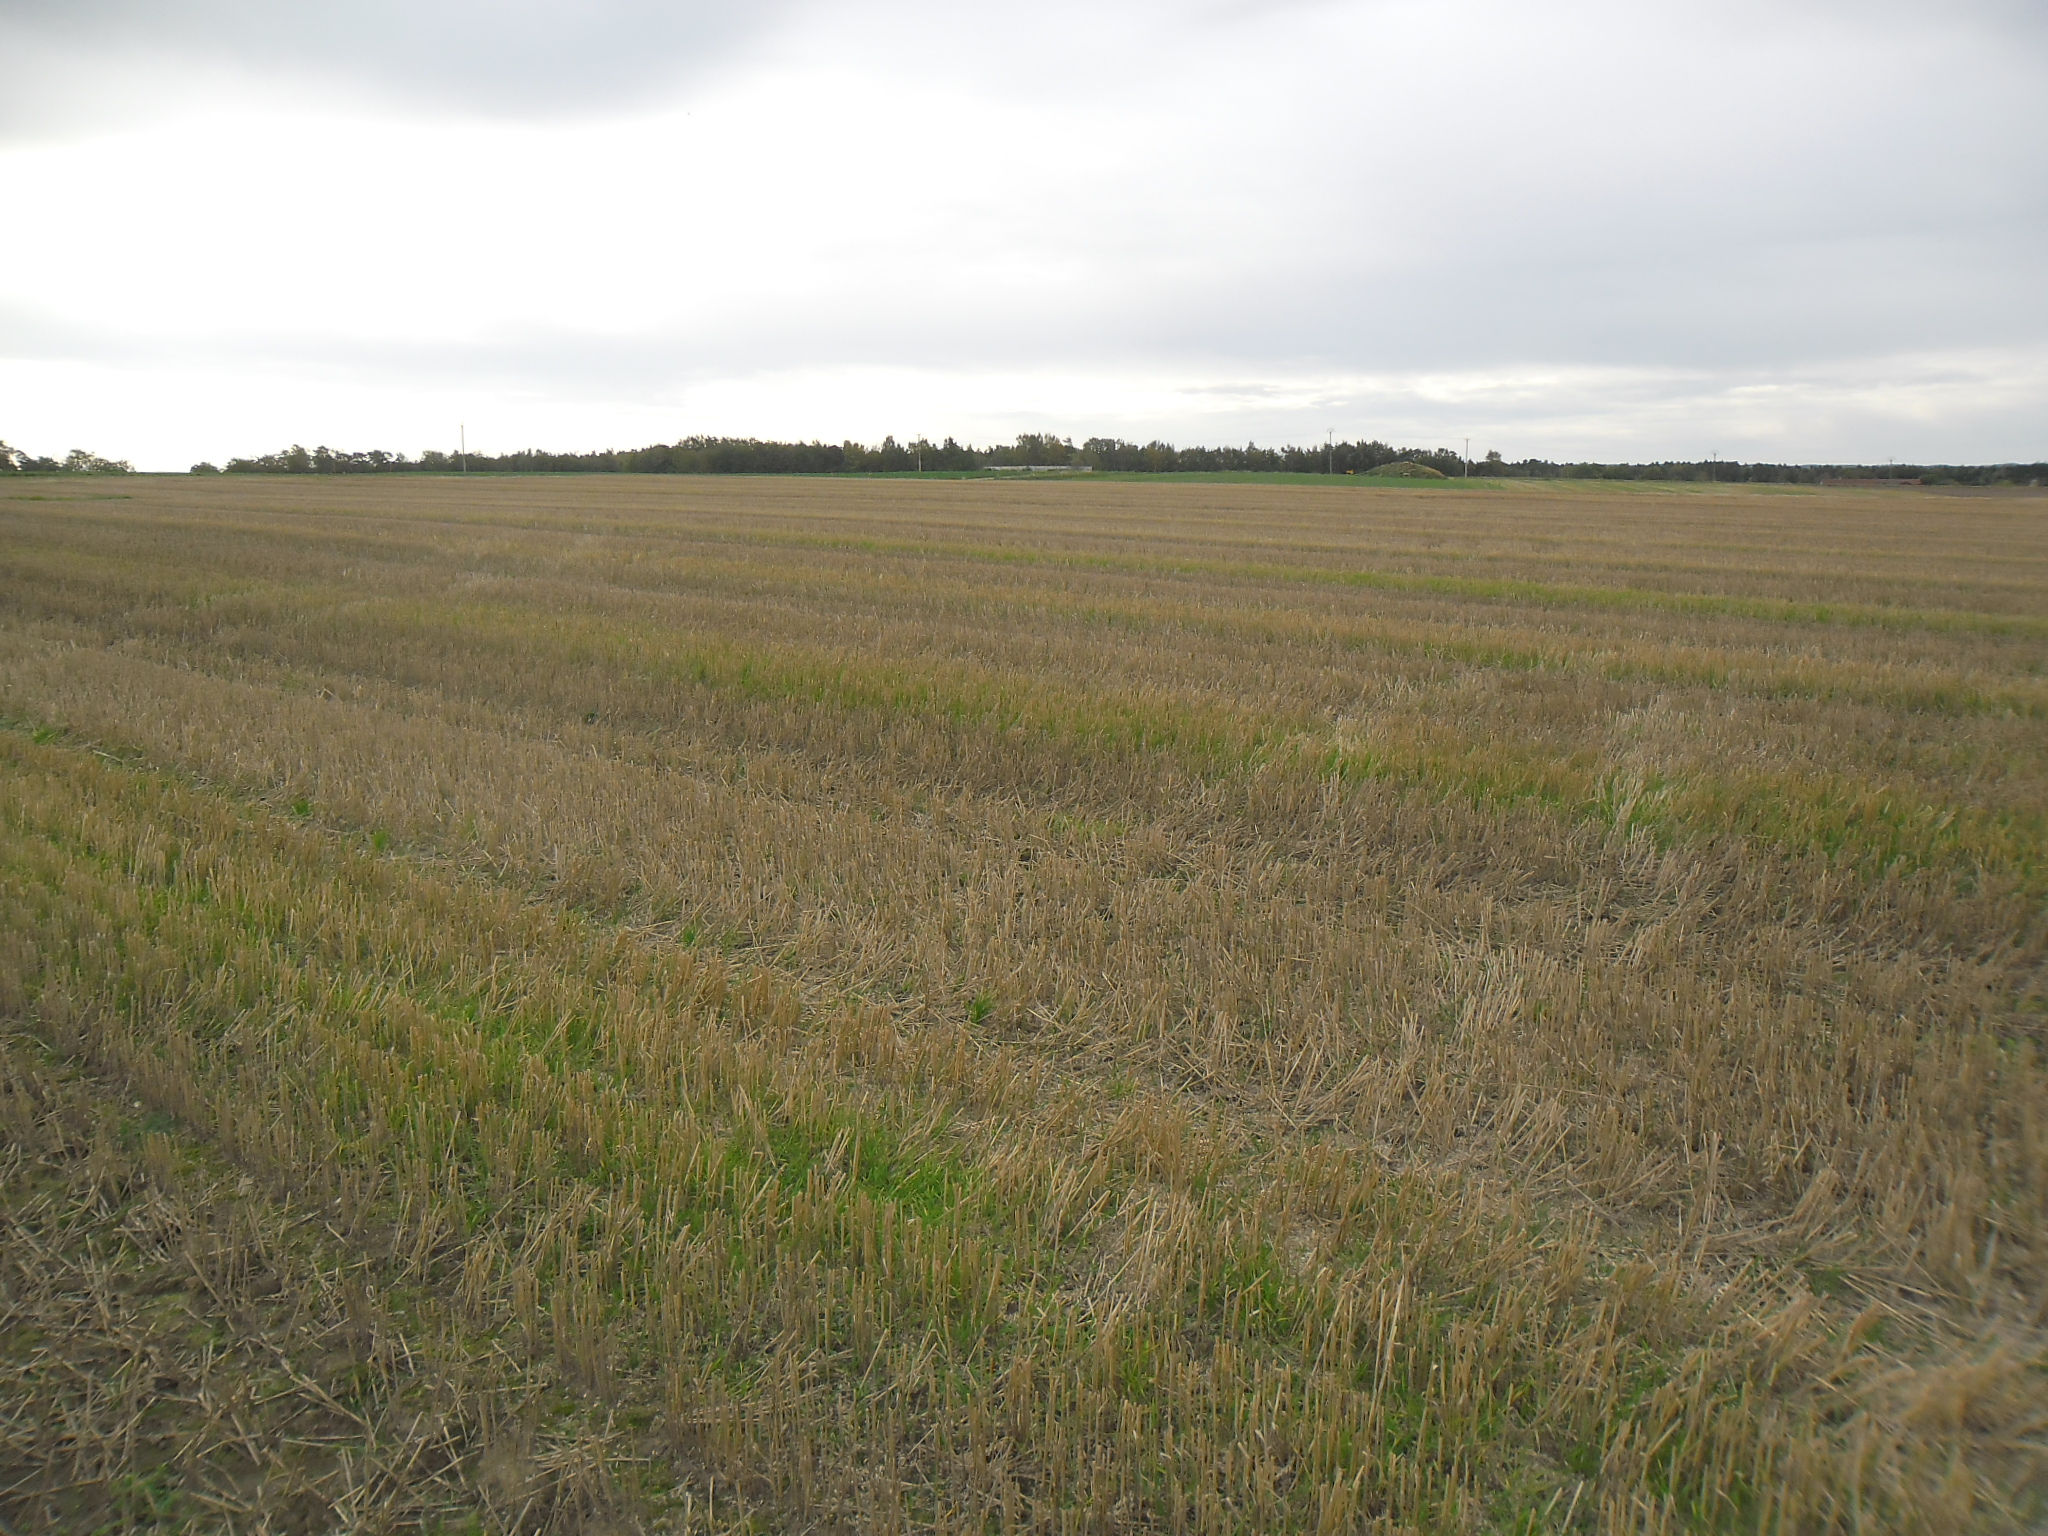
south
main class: Cropland
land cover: Common wheat
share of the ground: 10 - 25 %
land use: Agriculture (excluding fallow land and kitchen gardens)
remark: Harvested field
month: October
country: SE
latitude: 56.4743
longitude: 13.0978
